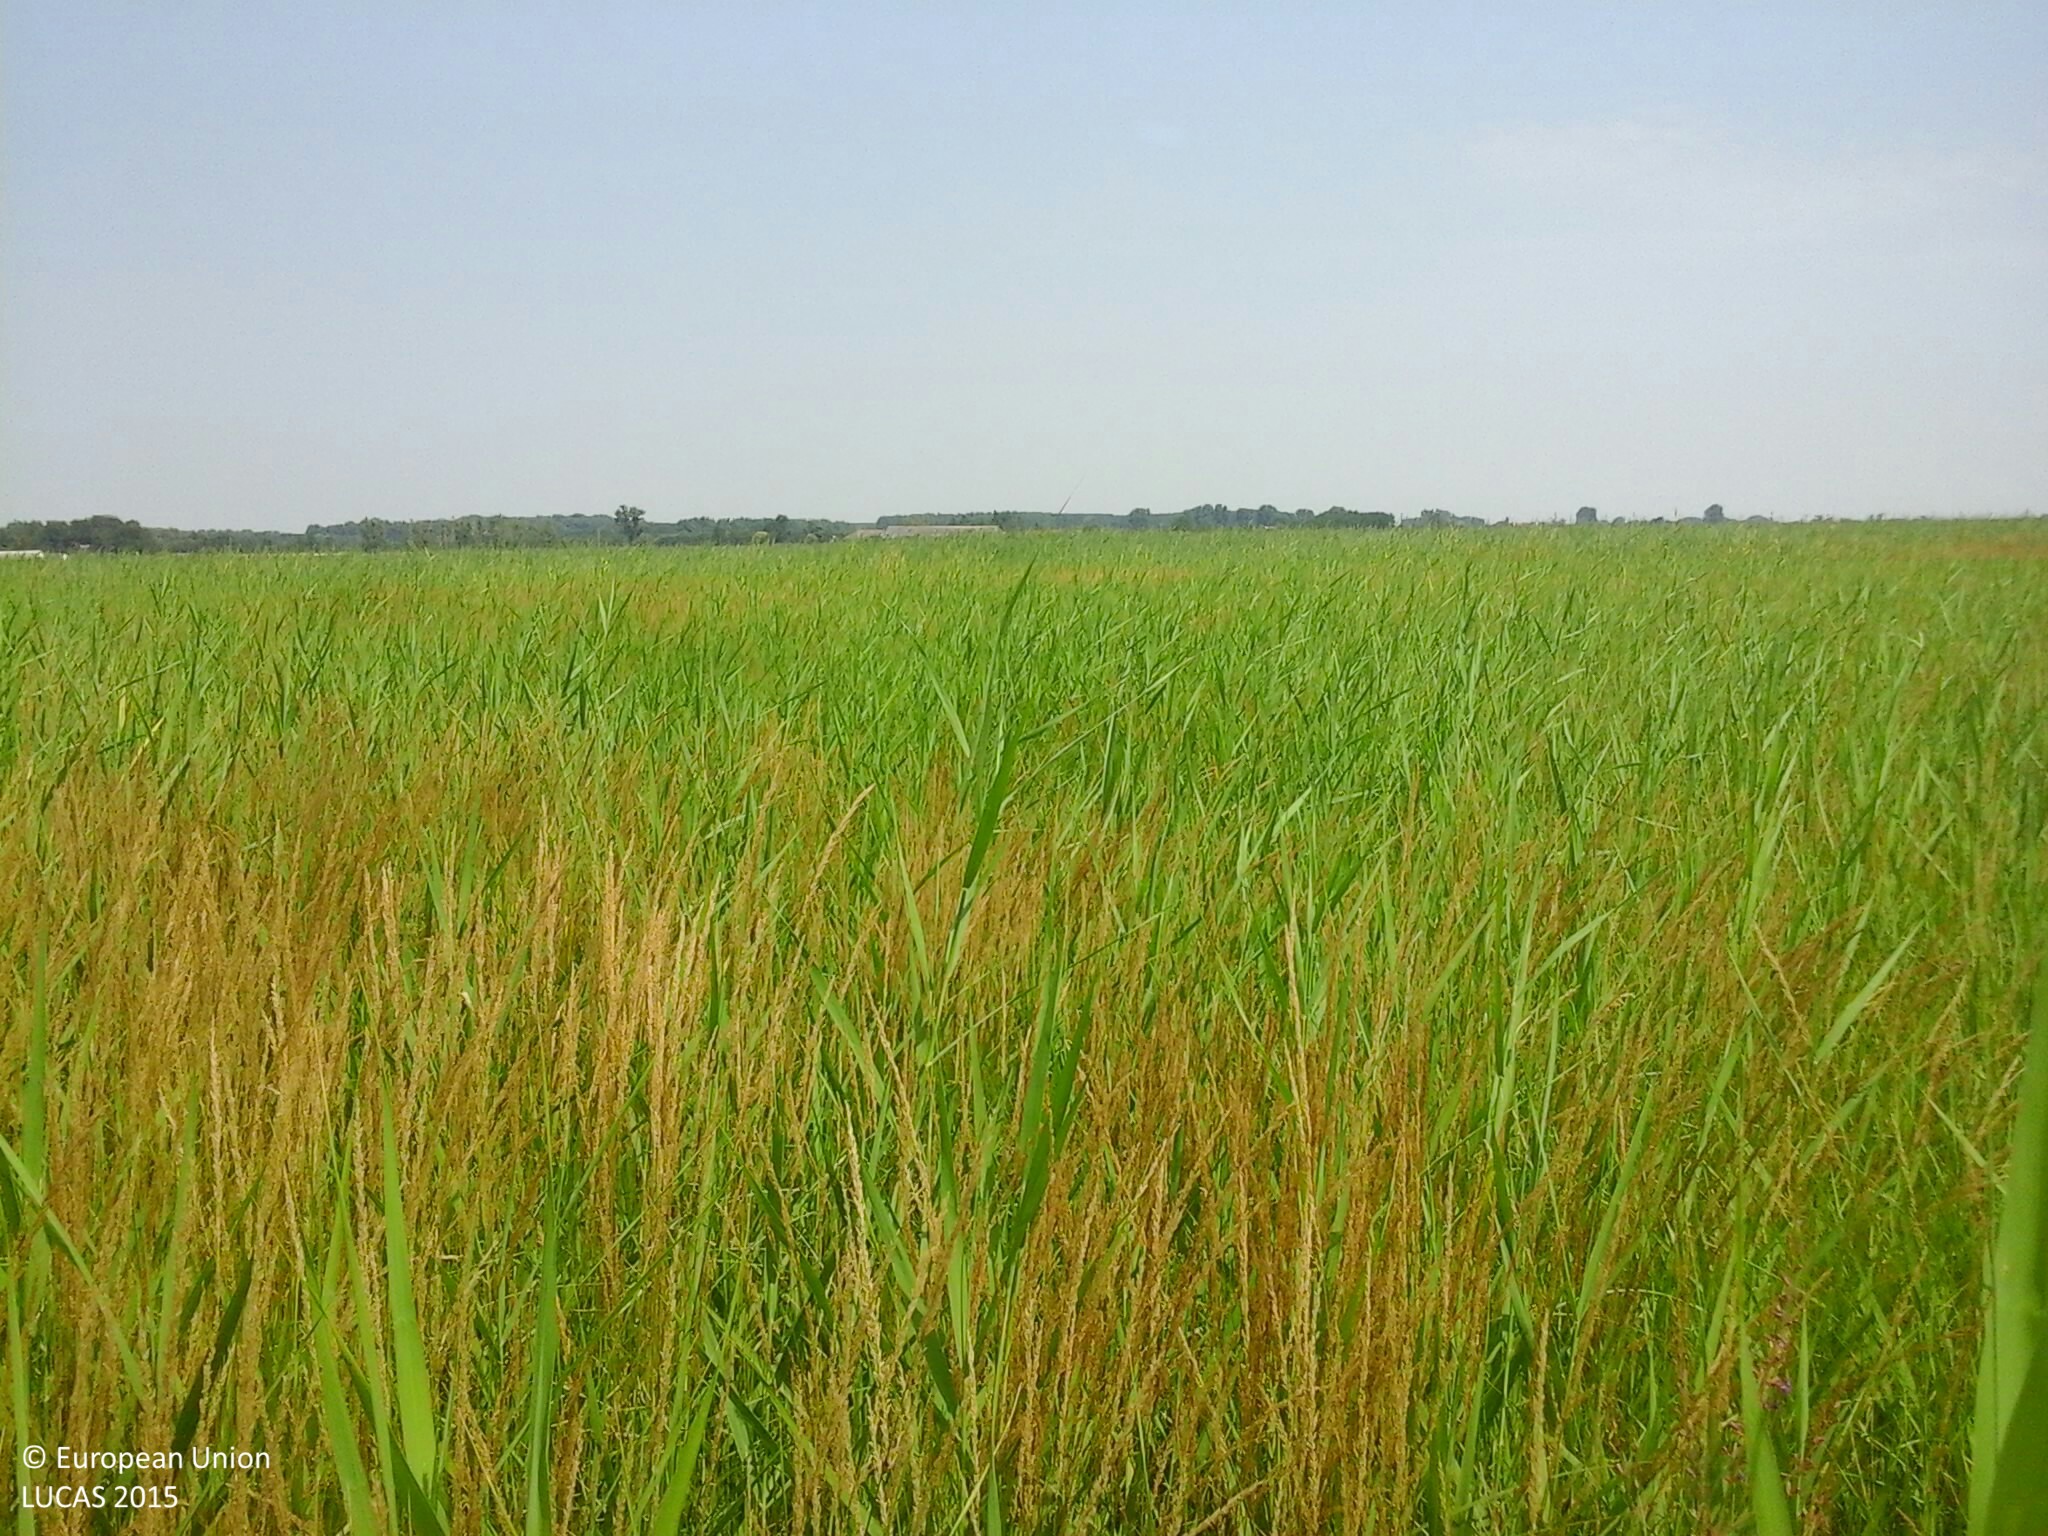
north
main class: Grassland
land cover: Grassland without tree/shrub cover
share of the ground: > 75 %
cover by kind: herbaceous plants 100 %
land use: Agriculture (excluding fallow land and kitchen gardens)
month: July
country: HU
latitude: 46.8434
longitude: 20.1875
